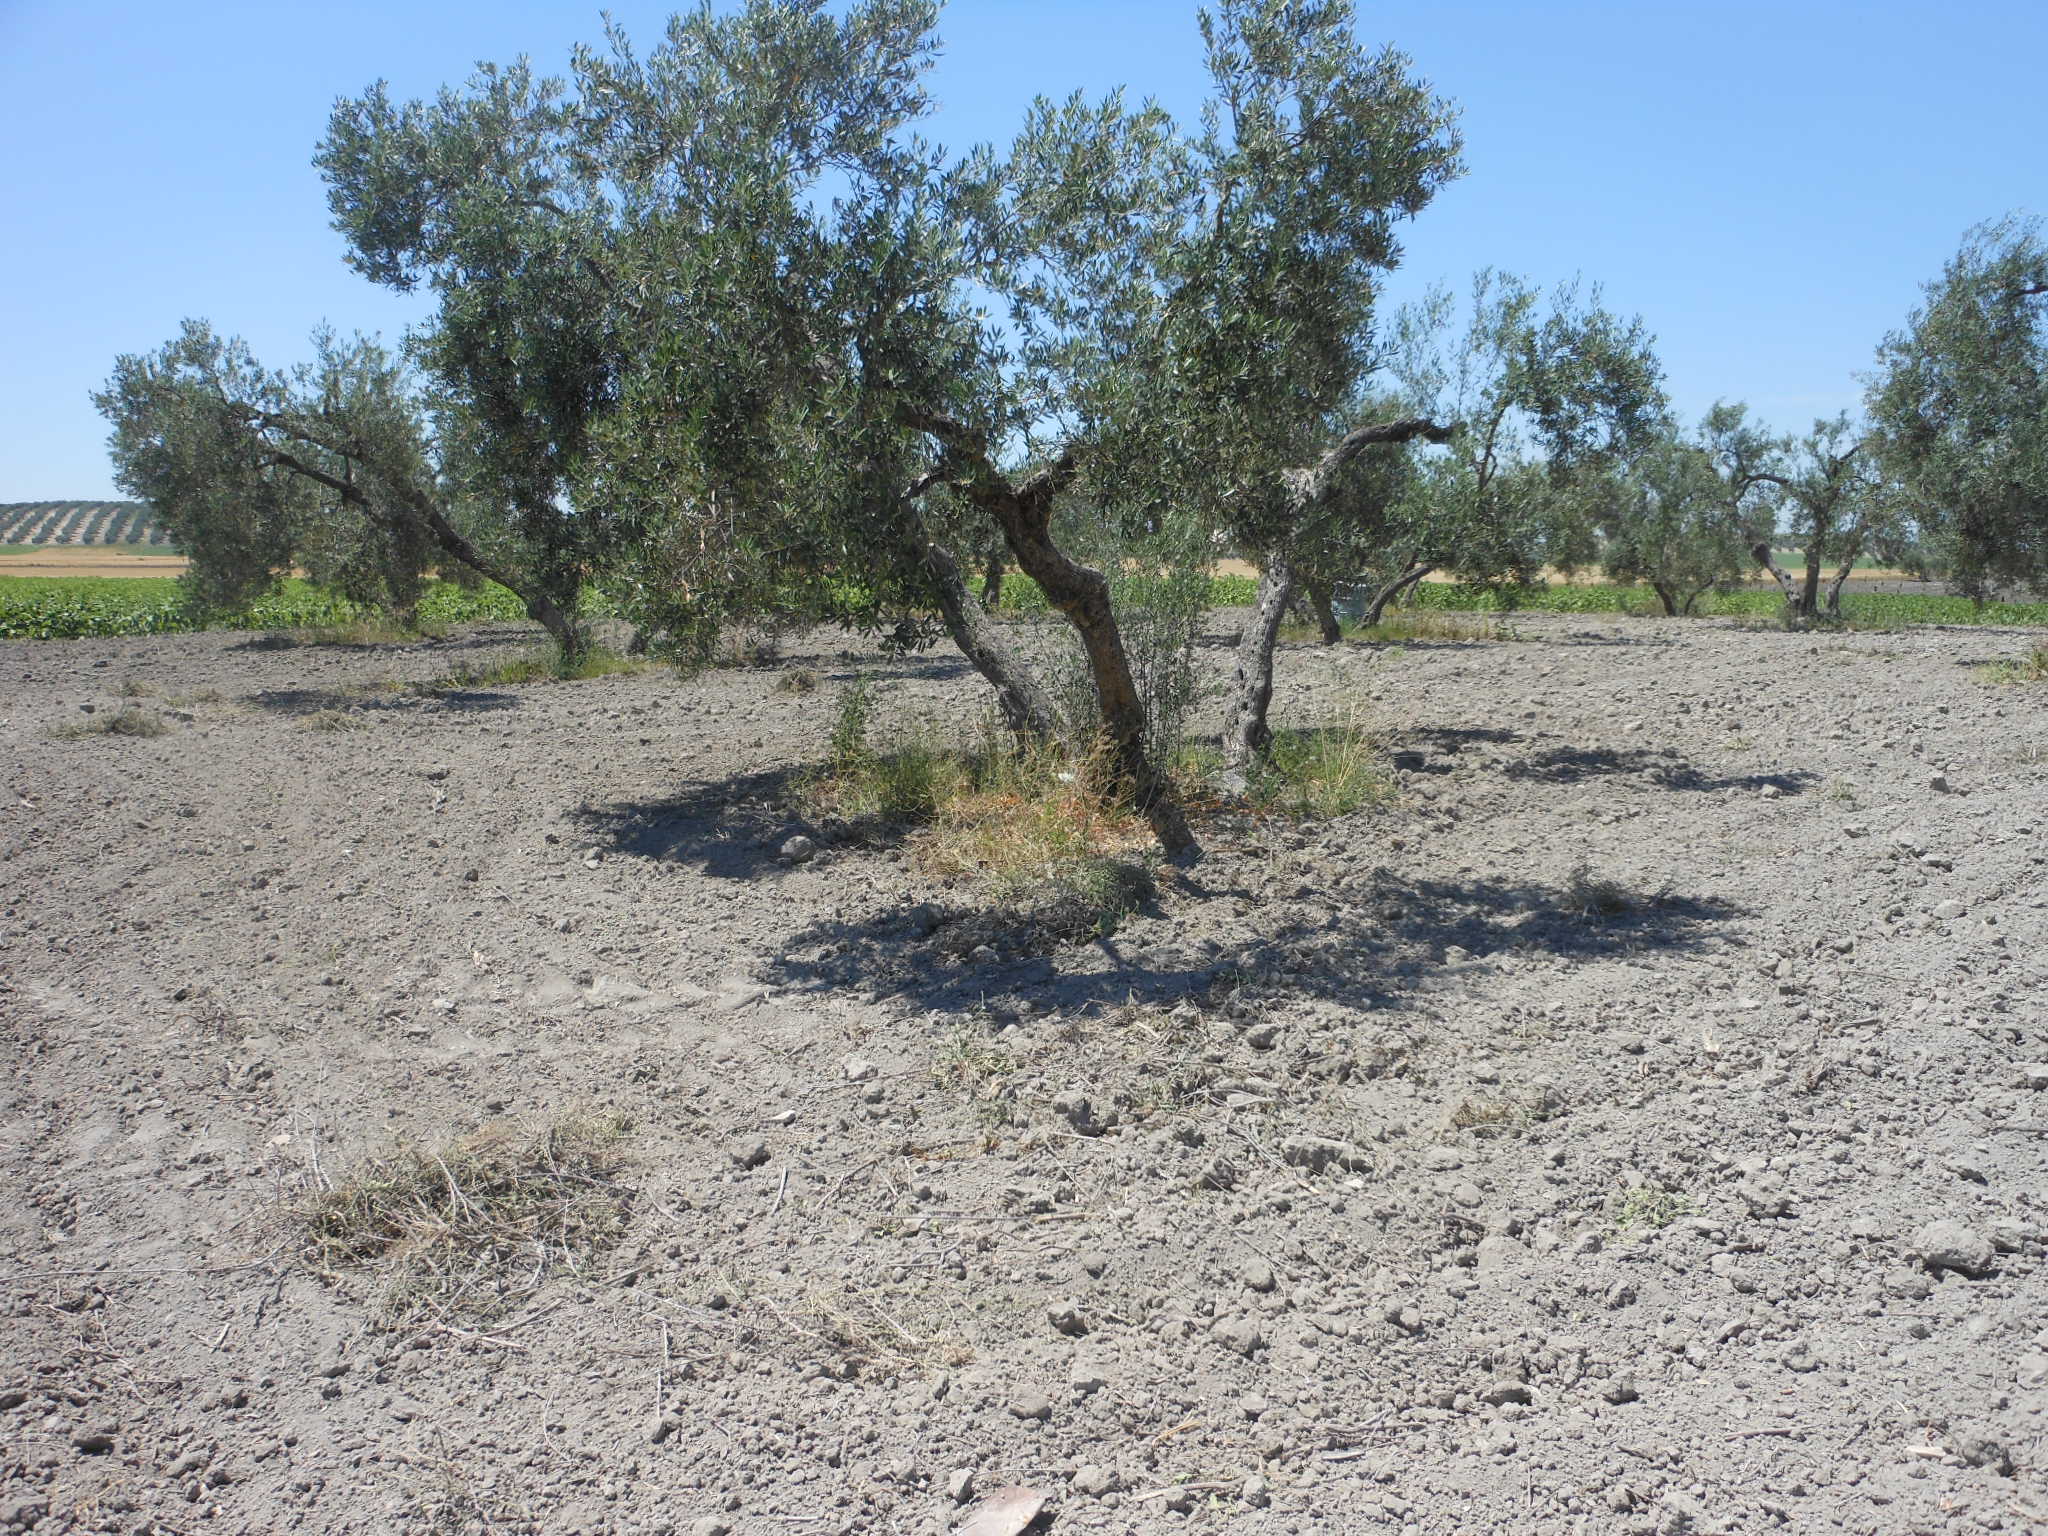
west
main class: Cropland
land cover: Olive groves
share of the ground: 10 - 25 %
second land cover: Other bare soil
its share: > 75 %
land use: Agriculture (excluding fallow land and kitchen gardens)
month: May
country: ES
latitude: 37.3035
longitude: -5.5734
